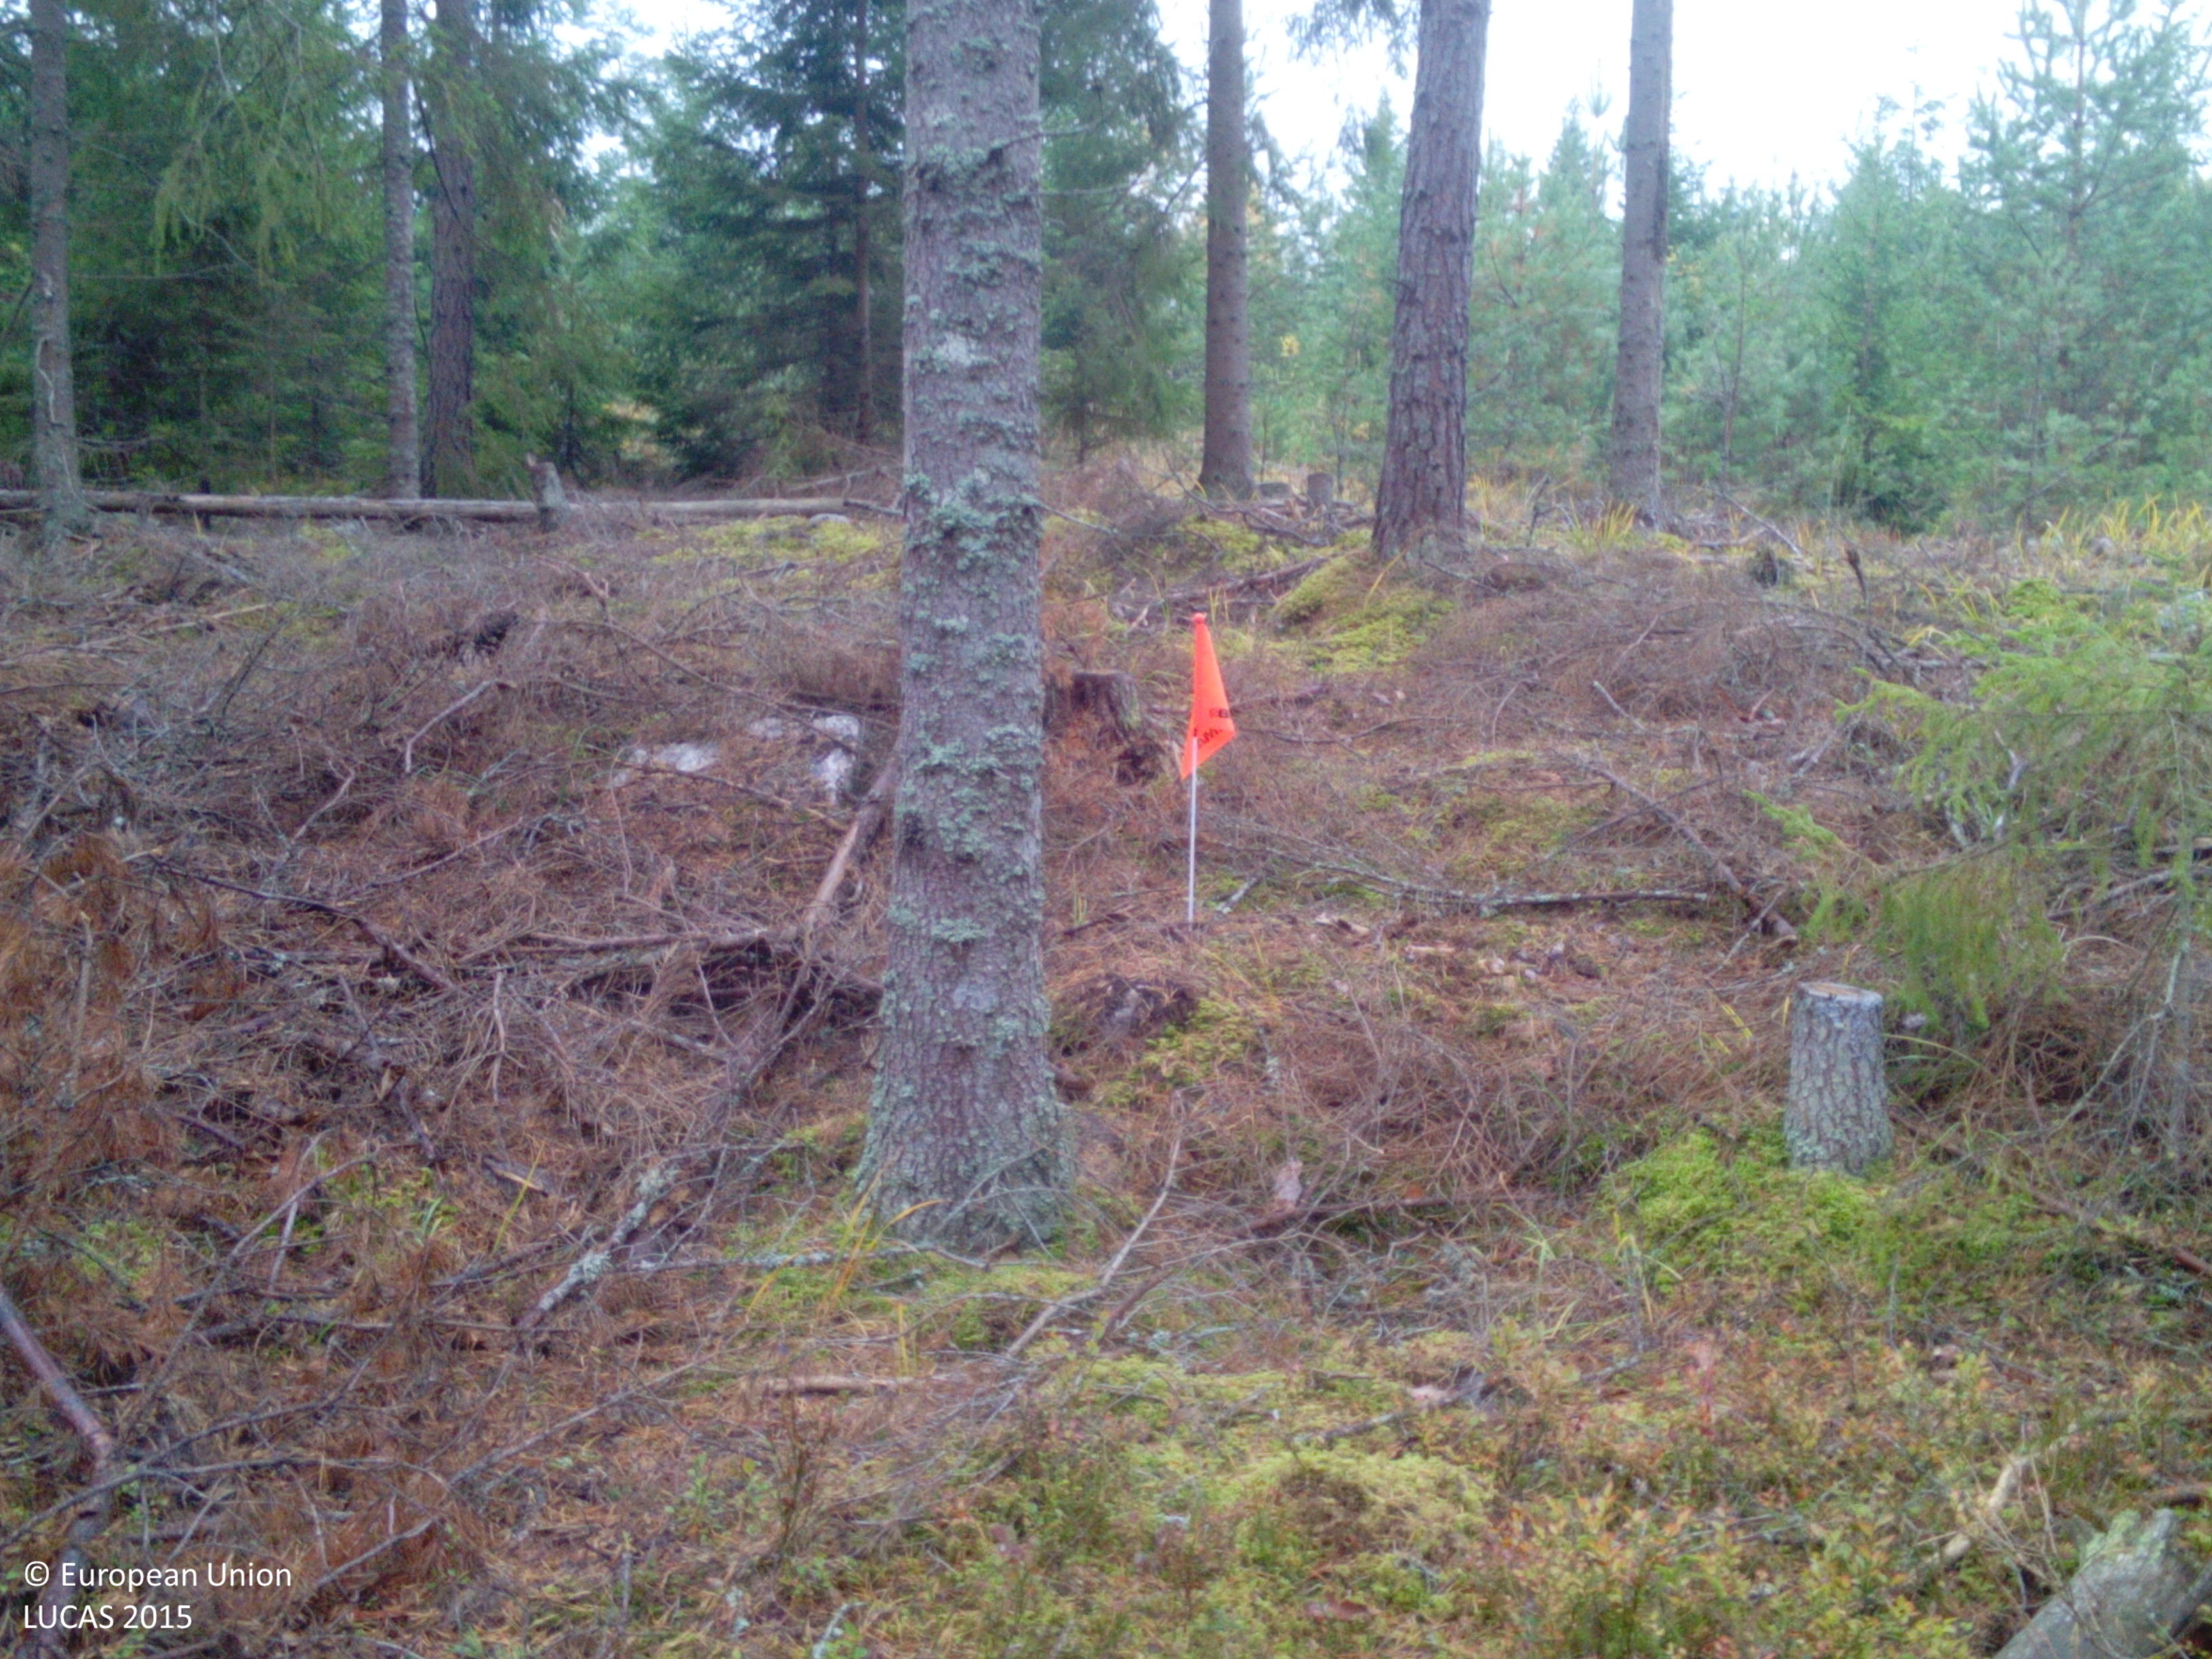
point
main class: Woodland
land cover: Other coniferous woodland
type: boreal forest
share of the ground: > 75 %
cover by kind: coniferous forest trees 85 %, lichens and mosses 10 %, herbaceous plants 5 %
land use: Forestry
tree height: > 5 m
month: October
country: SE
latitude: 59.1415
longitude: 16.1984
